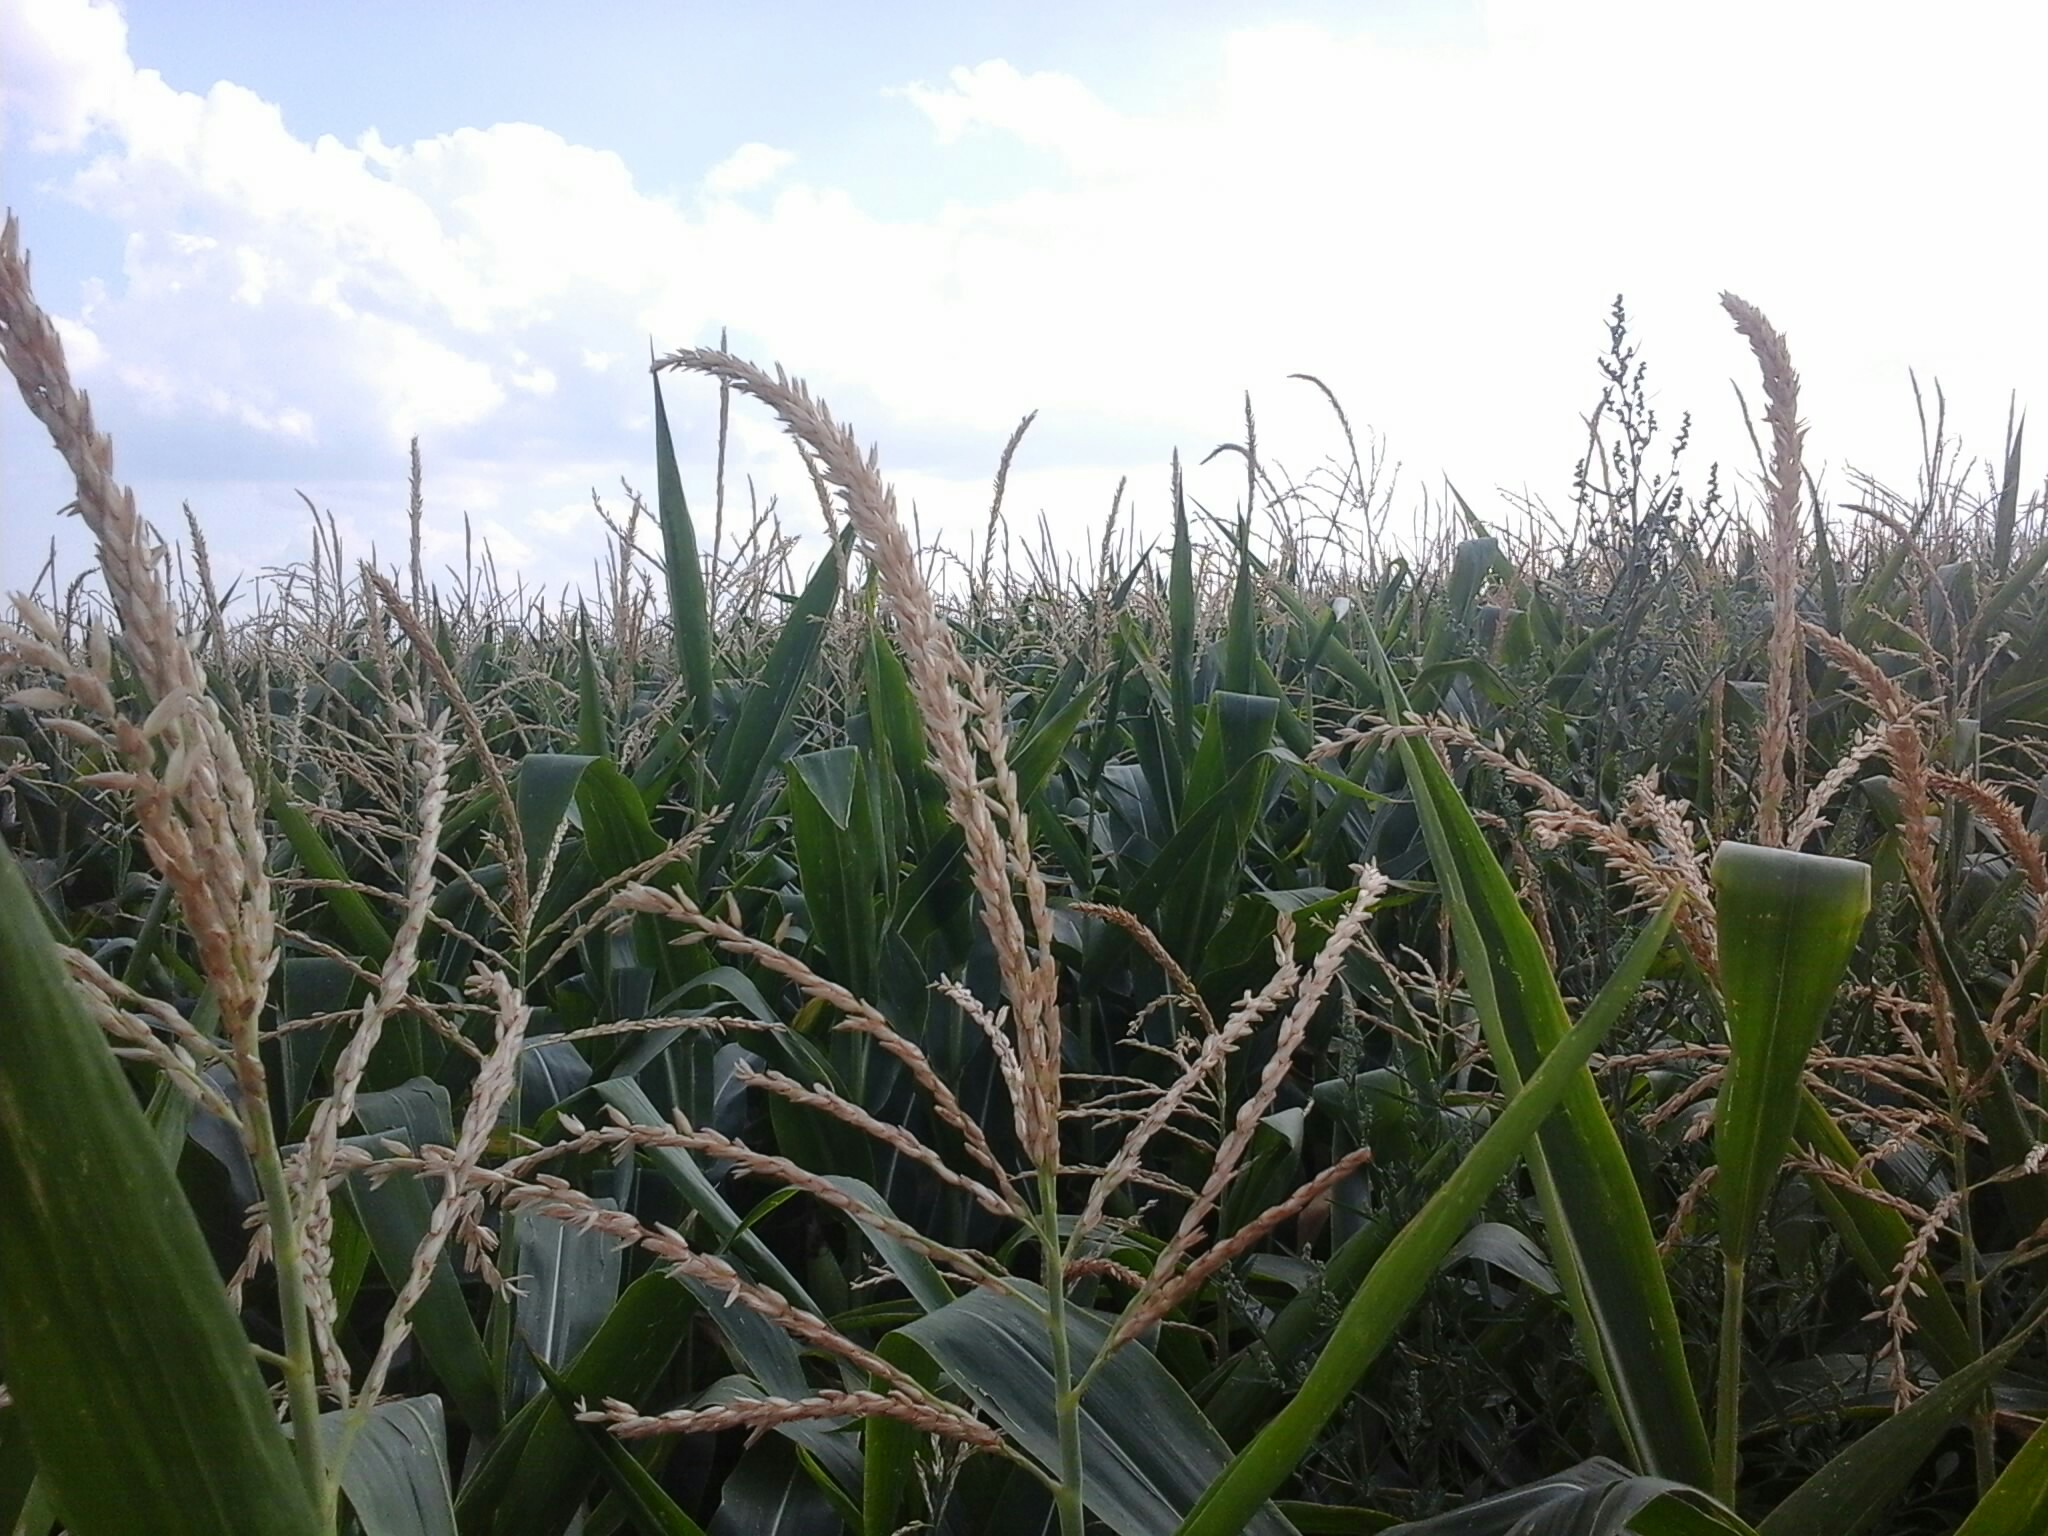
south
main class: Cropland
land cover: Maize
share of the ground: > 75 %
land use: Agriculture (excluding fallow land and kitchen gardens)
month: August
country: HU
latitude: 47.5054
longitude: 18.1502
